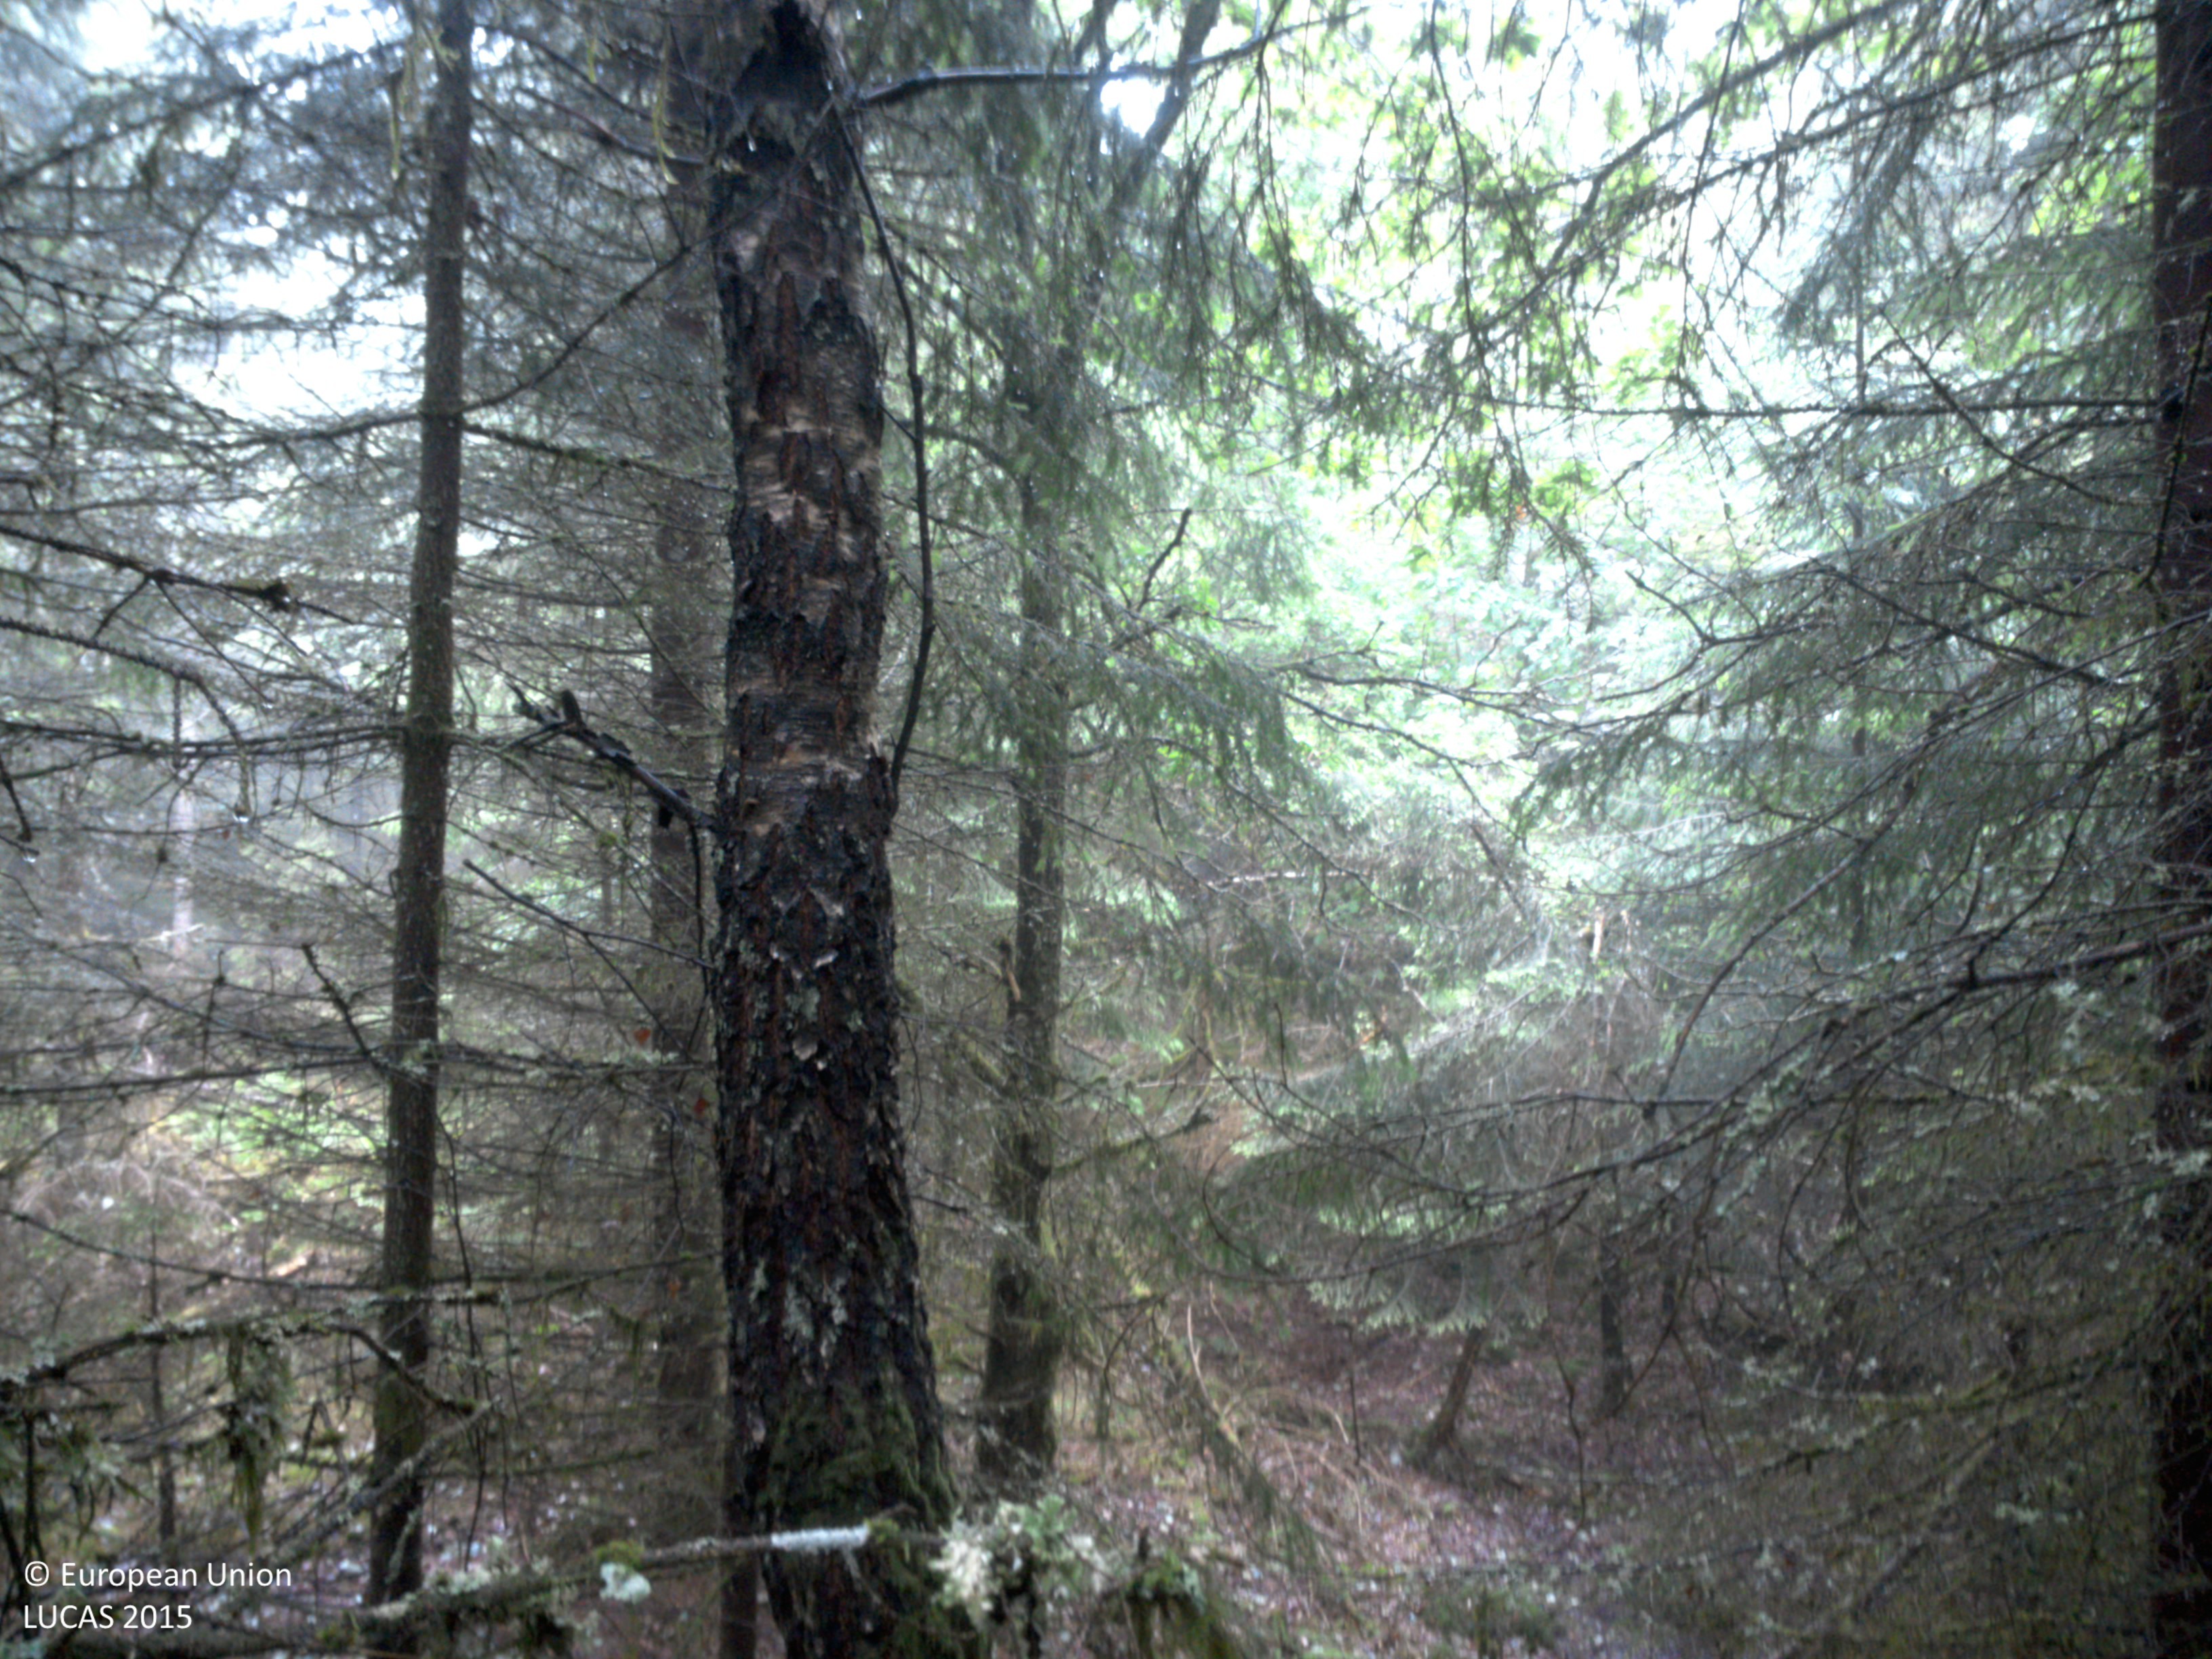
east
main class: Woodland
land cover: Spruce dominated coniferous woodland
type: boreal forest
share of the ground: > 75 %
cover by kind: coniferous forest trees 90 %, lichens and mosses 10 %
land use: Semi-natural and natural areas not in use
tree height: > 5 m
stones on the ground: < 10 %
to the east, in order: Spruce dominated coniferous woodland; Broadleaved woodland; Spruce dominated coniferous woodland; Spruce dominated mixed woodland; Spruce dominated coniferous woodland
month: July
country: SE
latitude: 58.6347
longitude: 12.1142
